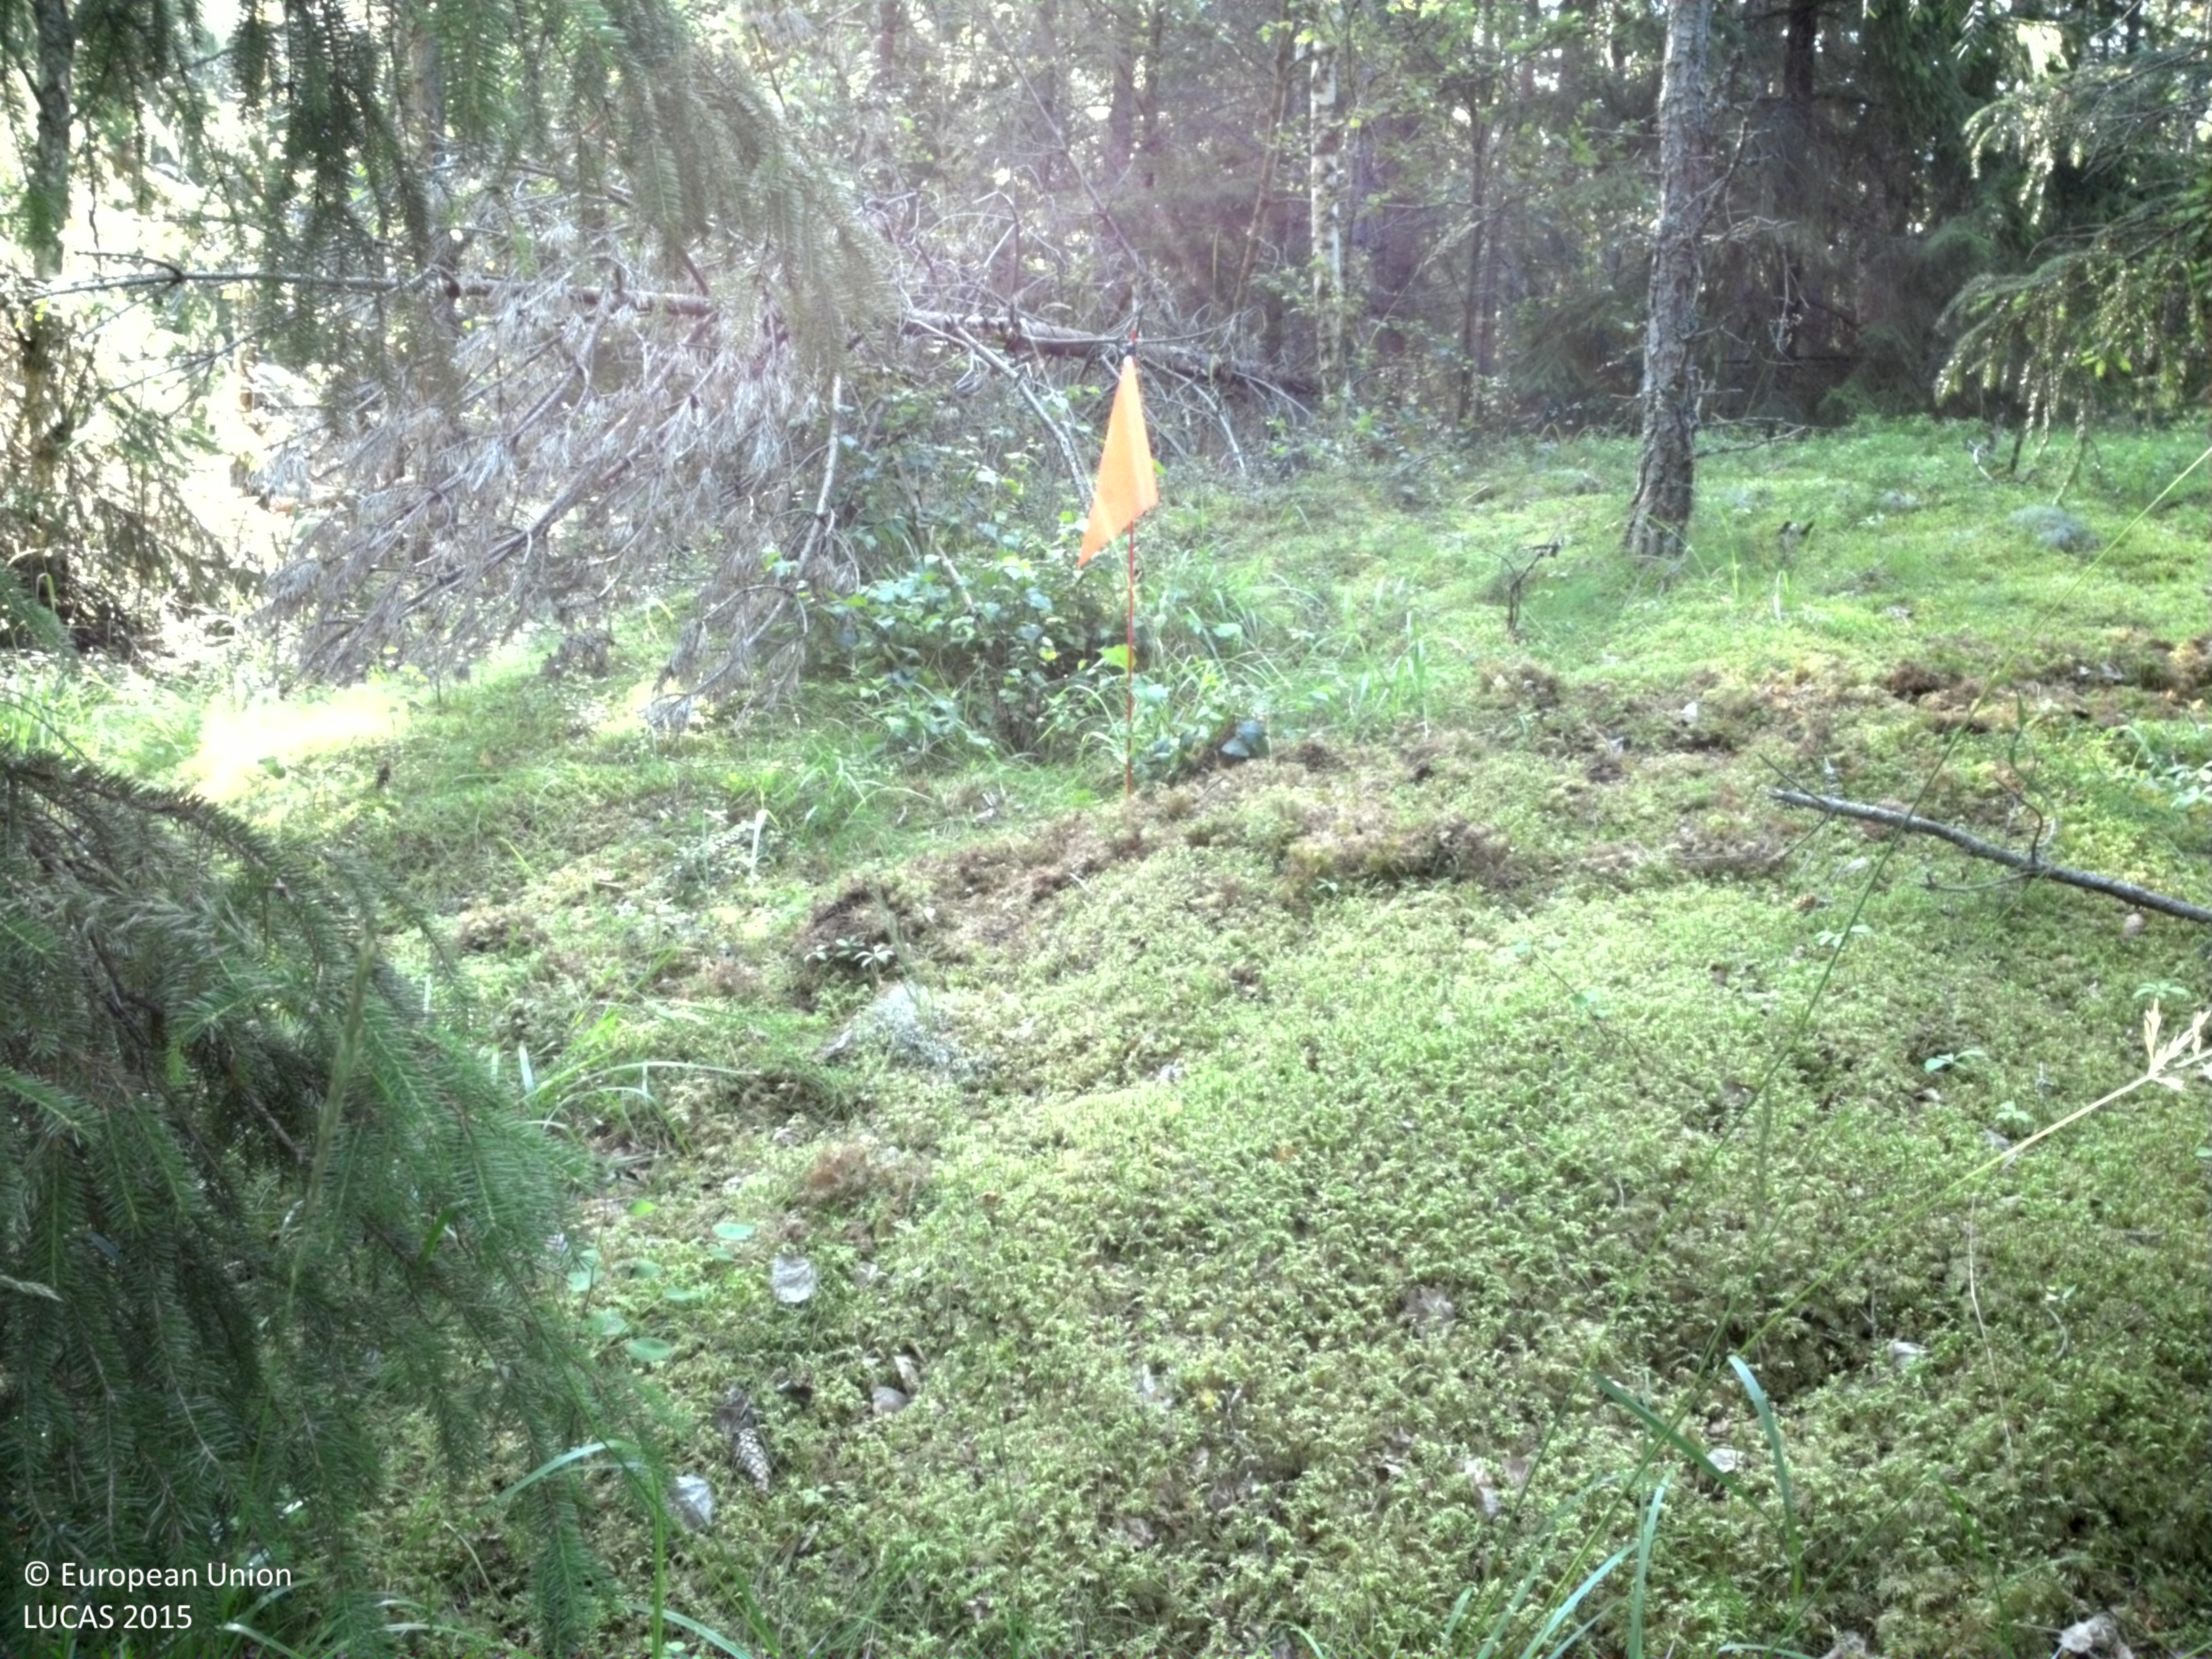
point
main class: Woodland
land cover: Spruce dominated coniferous woodland
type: boreal forest
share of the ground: 50 - 75 %
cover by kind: coniferous forest trees 65 %, lichens and mosses 25 %, broadleaved forest trees 10 %
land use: Forestry
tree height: > 5 m
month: July
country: SE
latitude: 59.7193
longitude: 18.5872
